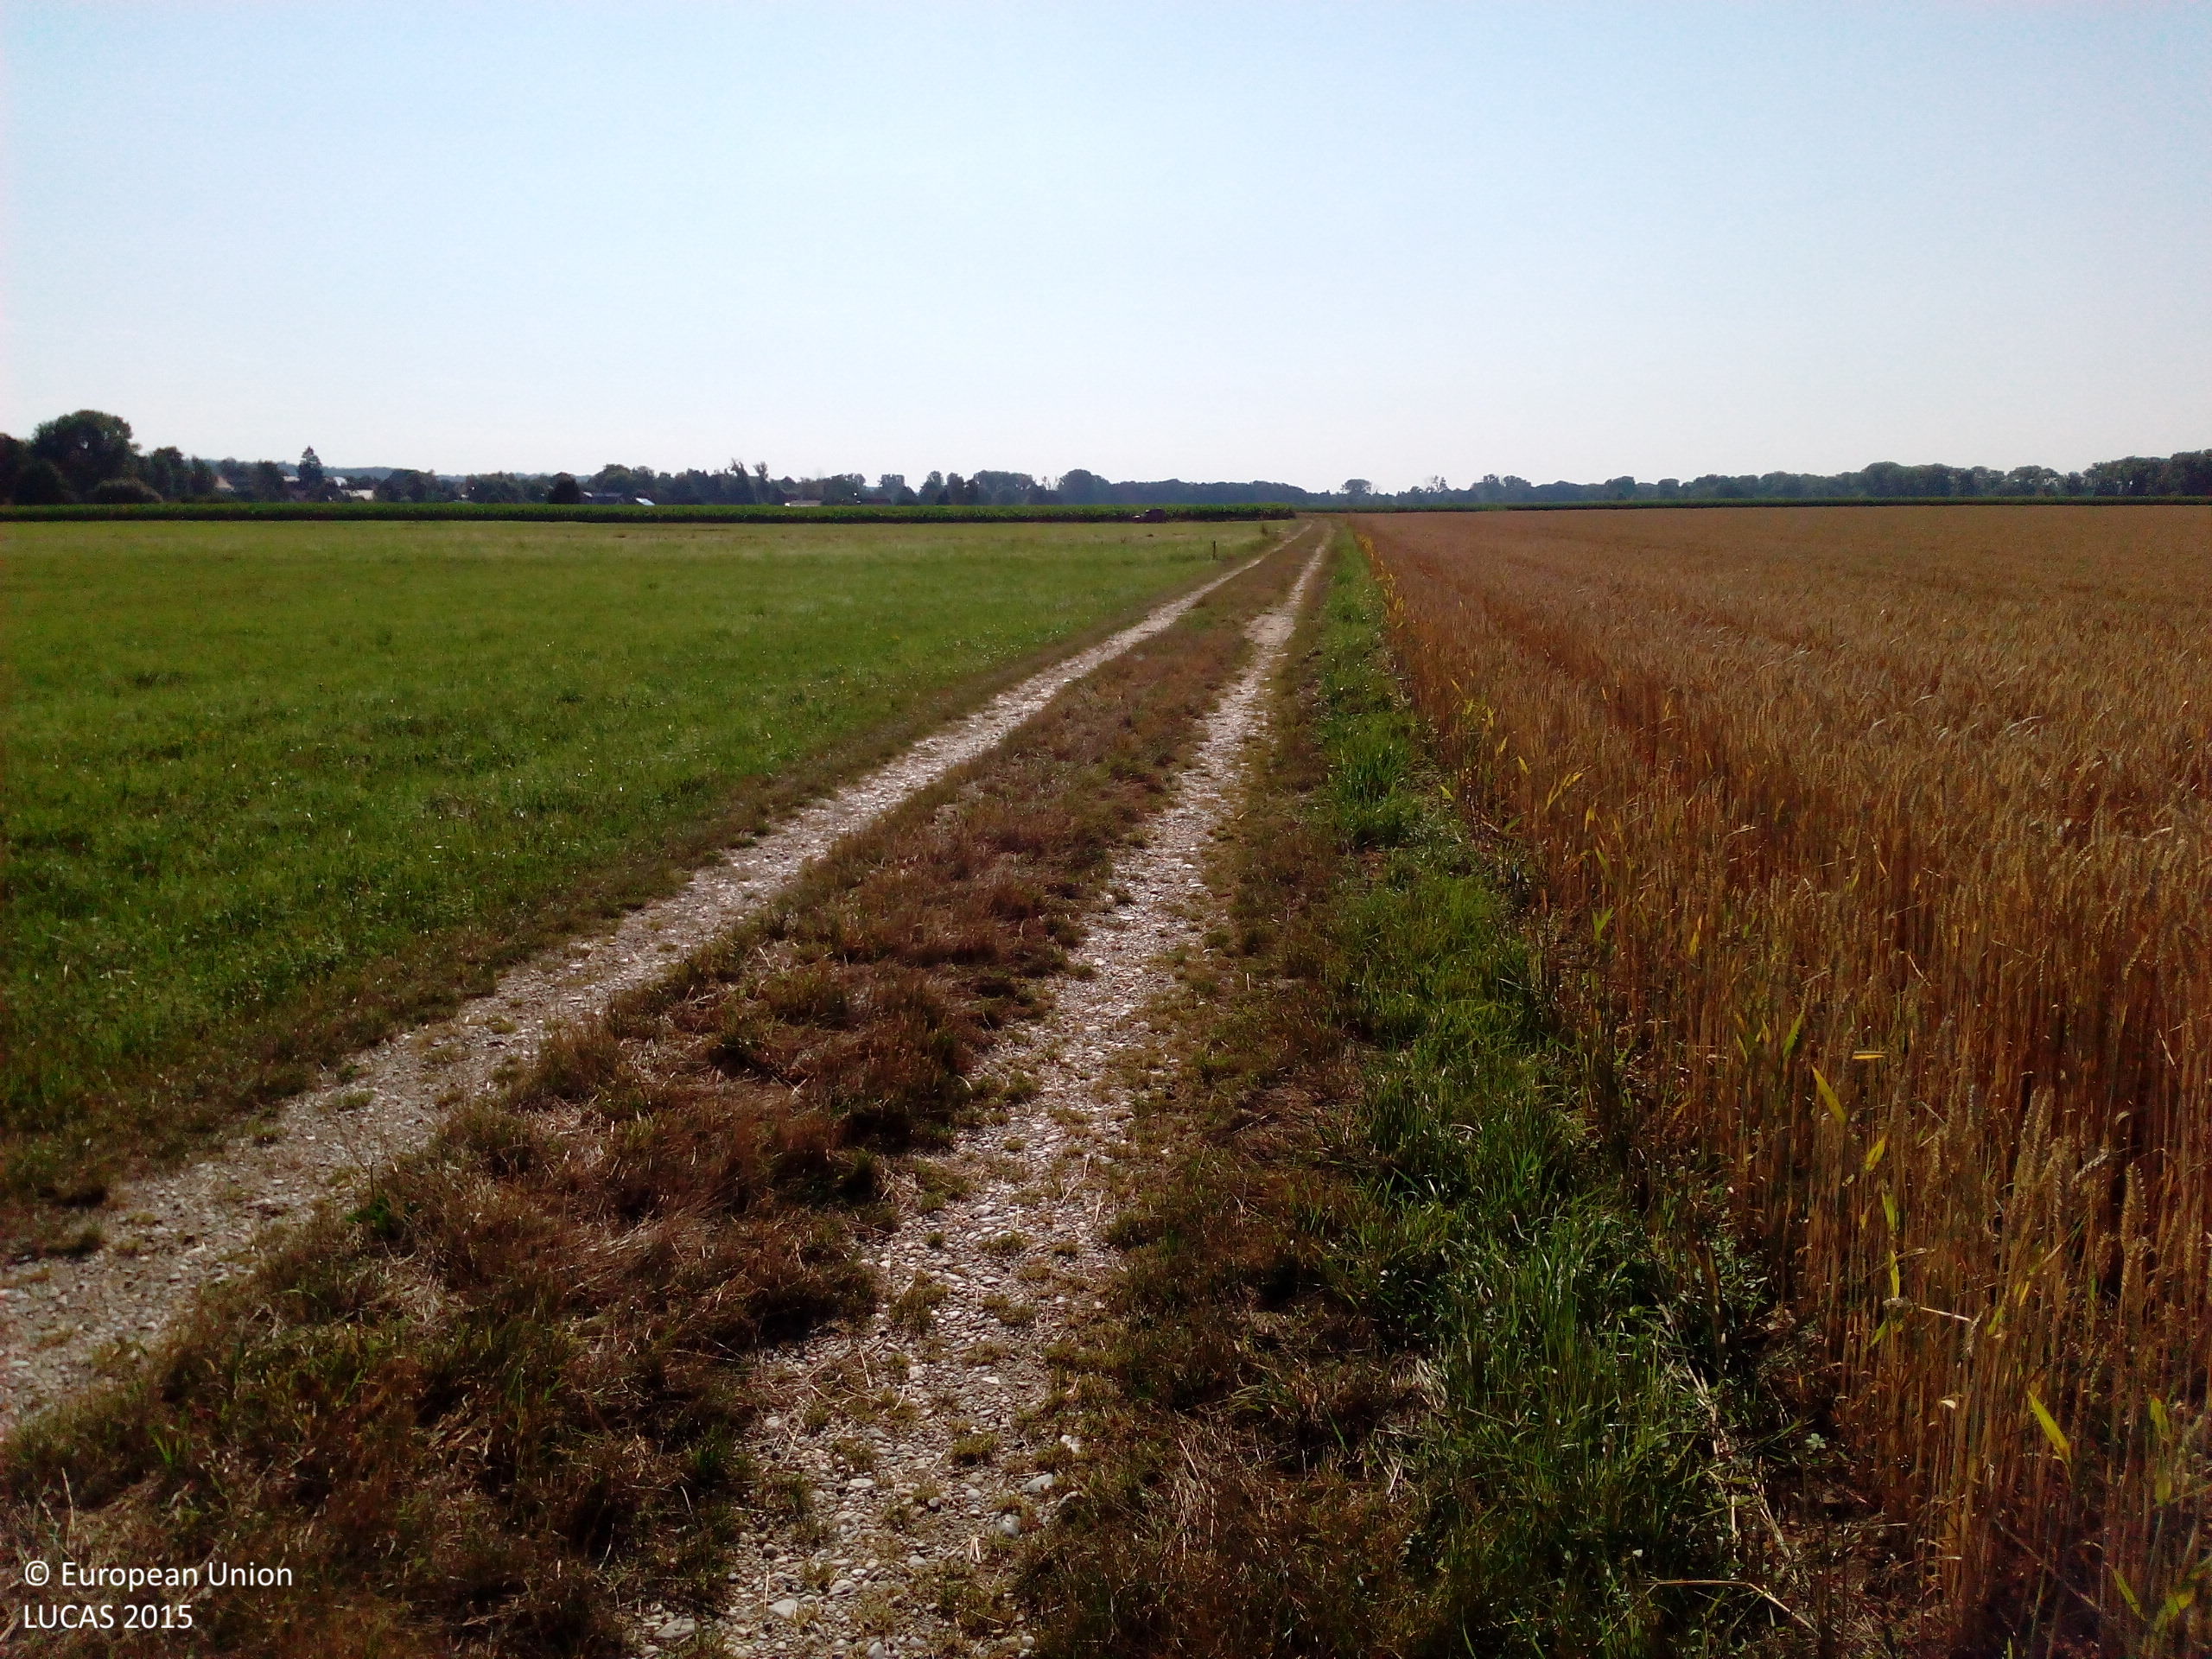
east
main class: Cropland
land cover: Common wheat
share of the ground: > 75 %
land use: Agriculture (excluding fallow land and kitchen gardens)
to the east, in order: Common wheat; Tracks; Grassland without tree/shrub cover; Tracks; Grass margins; Maize
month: July
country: DE
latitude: 48.6351
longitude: 12.9168
